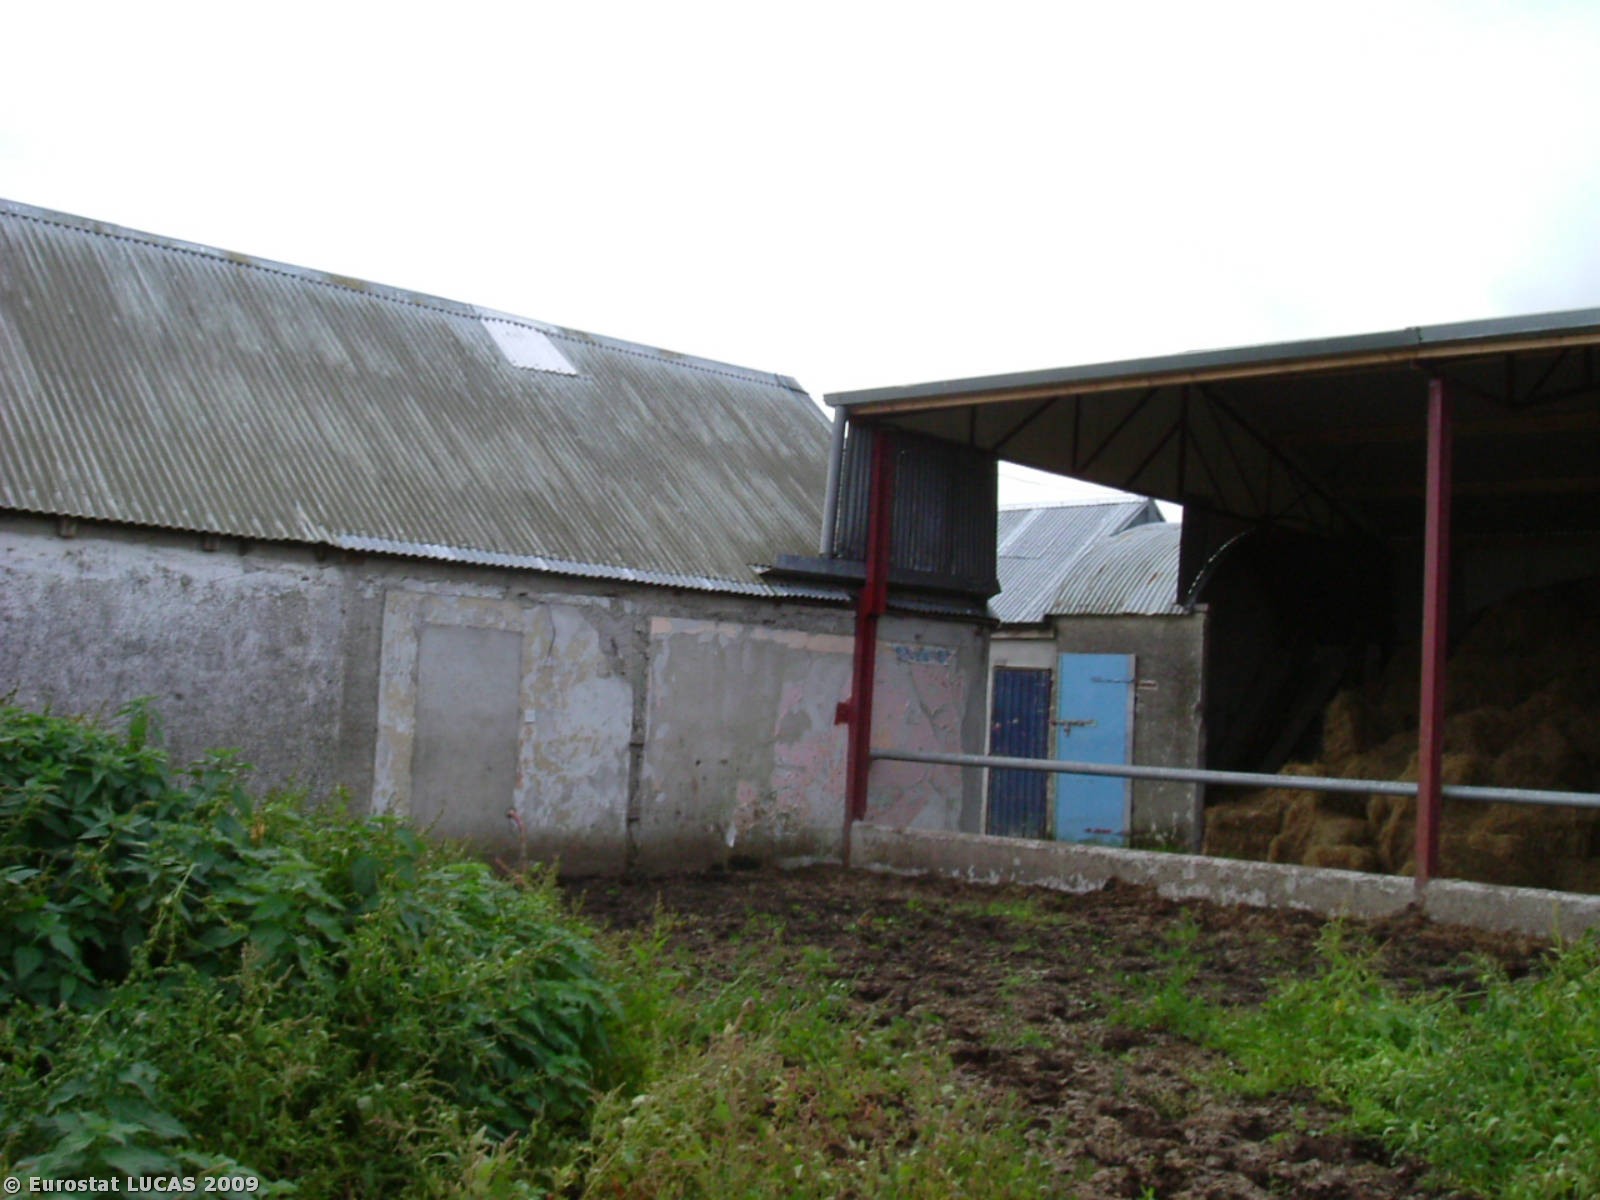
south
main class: Grassland
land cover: Spontaneously vegetated surfaces
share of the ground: > 75 %
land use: Fallow land
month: October
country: IE
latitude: 52.7258
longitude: -7.7121
